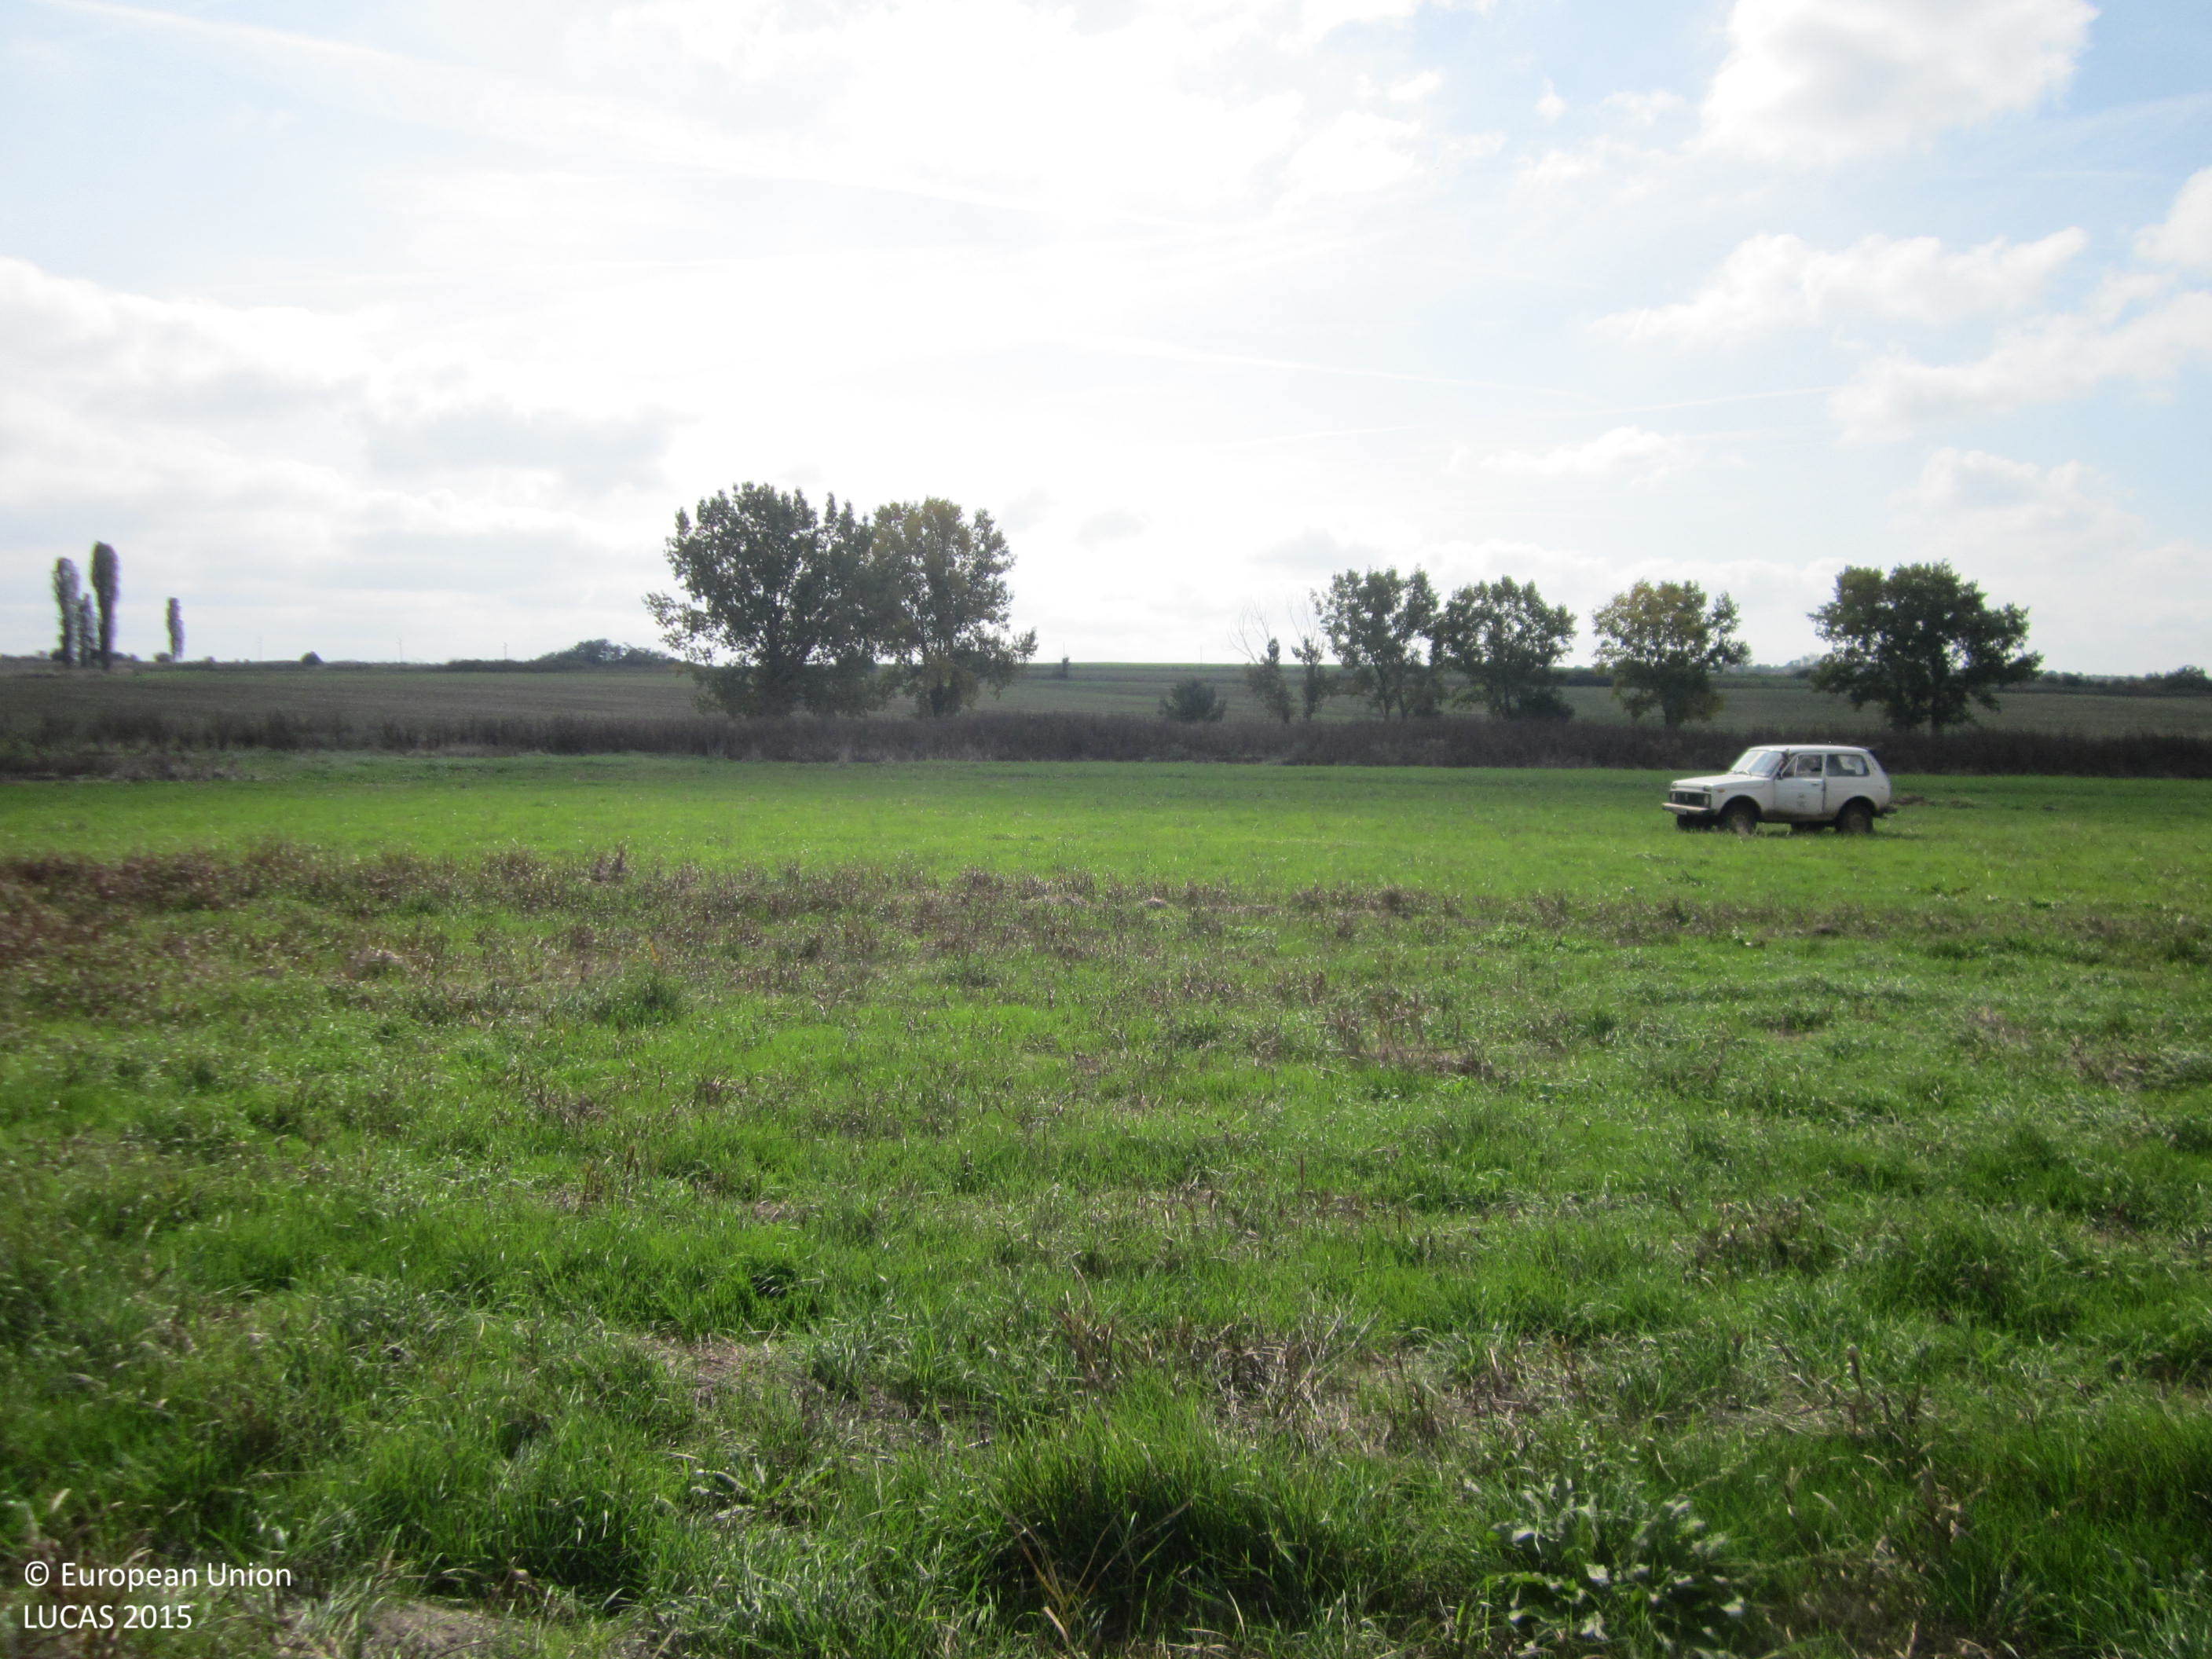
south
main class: Grassland
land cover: Grassland without tree/shrub cover
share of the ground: > 75 %
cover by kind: herbaceous plants 100 %
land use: Agriculture (excluding fallow land and kitchen gardens)
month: October
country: BG
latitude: 42.6964
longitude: 26.8888
